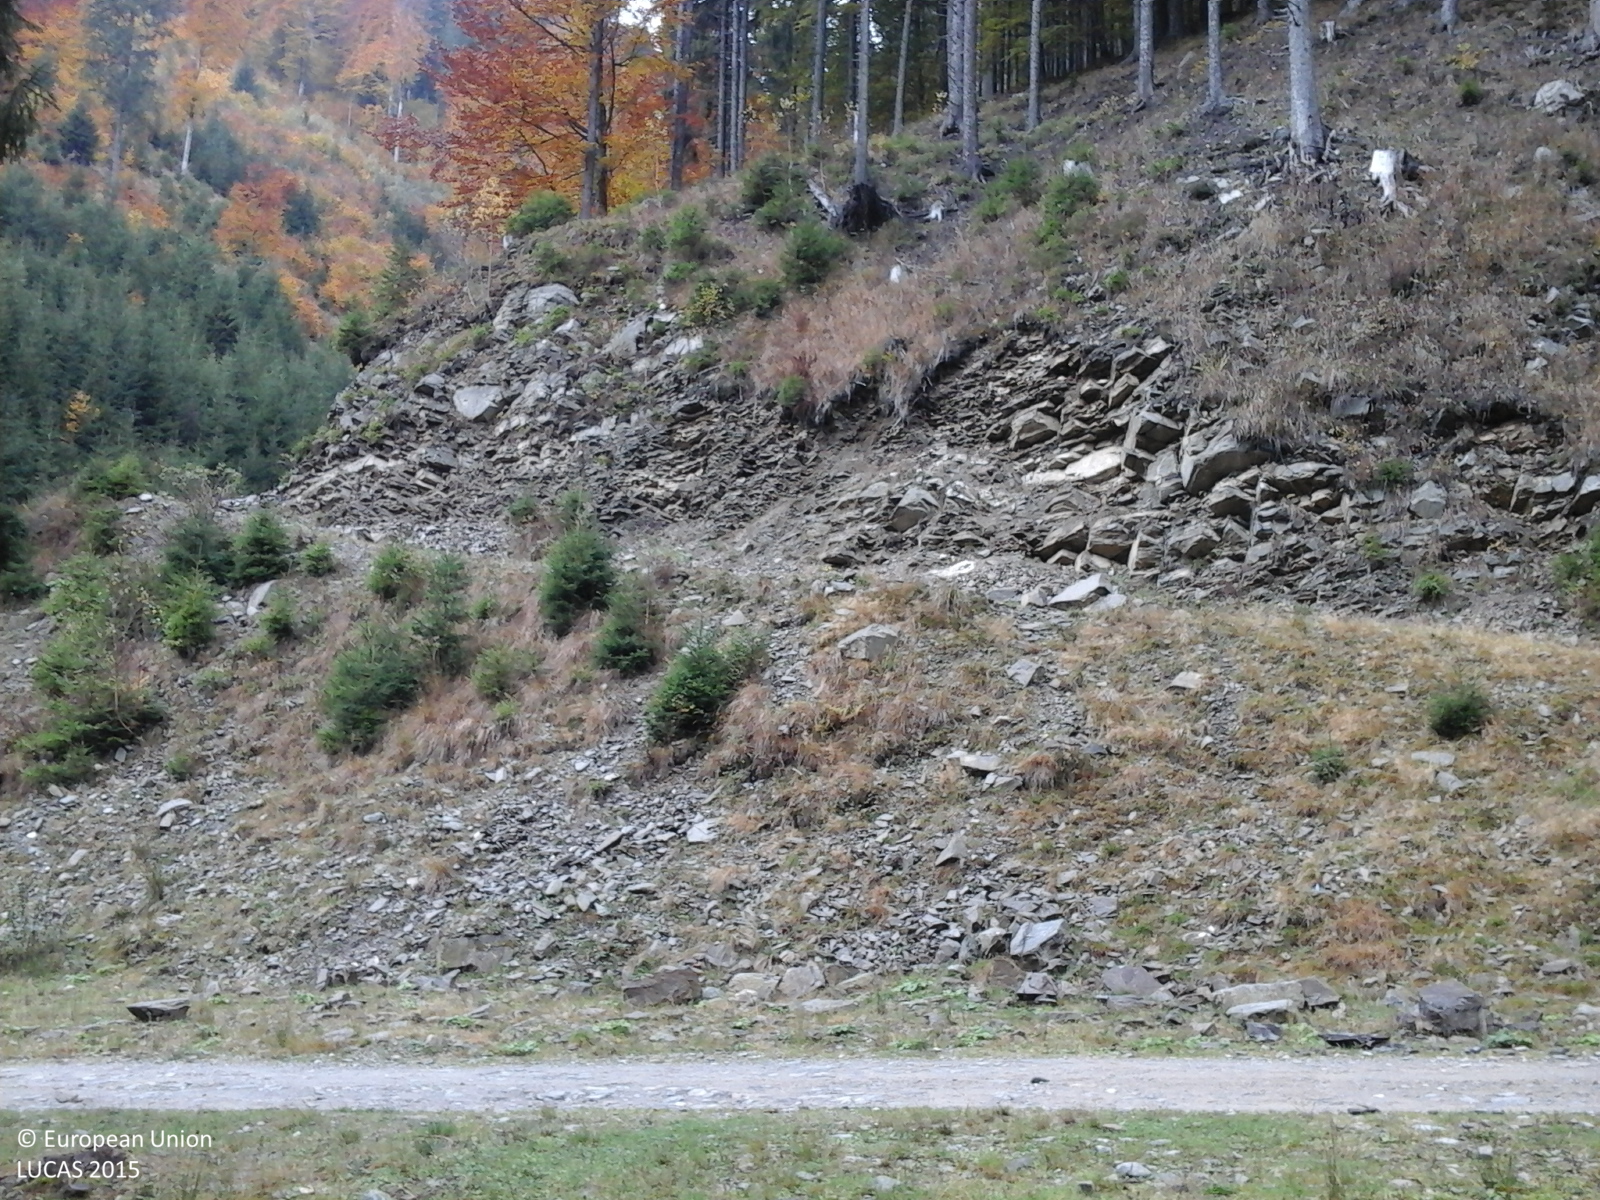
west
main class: Grassland
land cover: Grassland without tree/shrub cover
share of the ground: 50 - 75 %
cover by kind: herbaceous plants 75 %
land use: Agriculture (excluding fallow land and kitchen gardens)
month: October
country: RO
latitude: 45.4631
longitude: 25.0411
